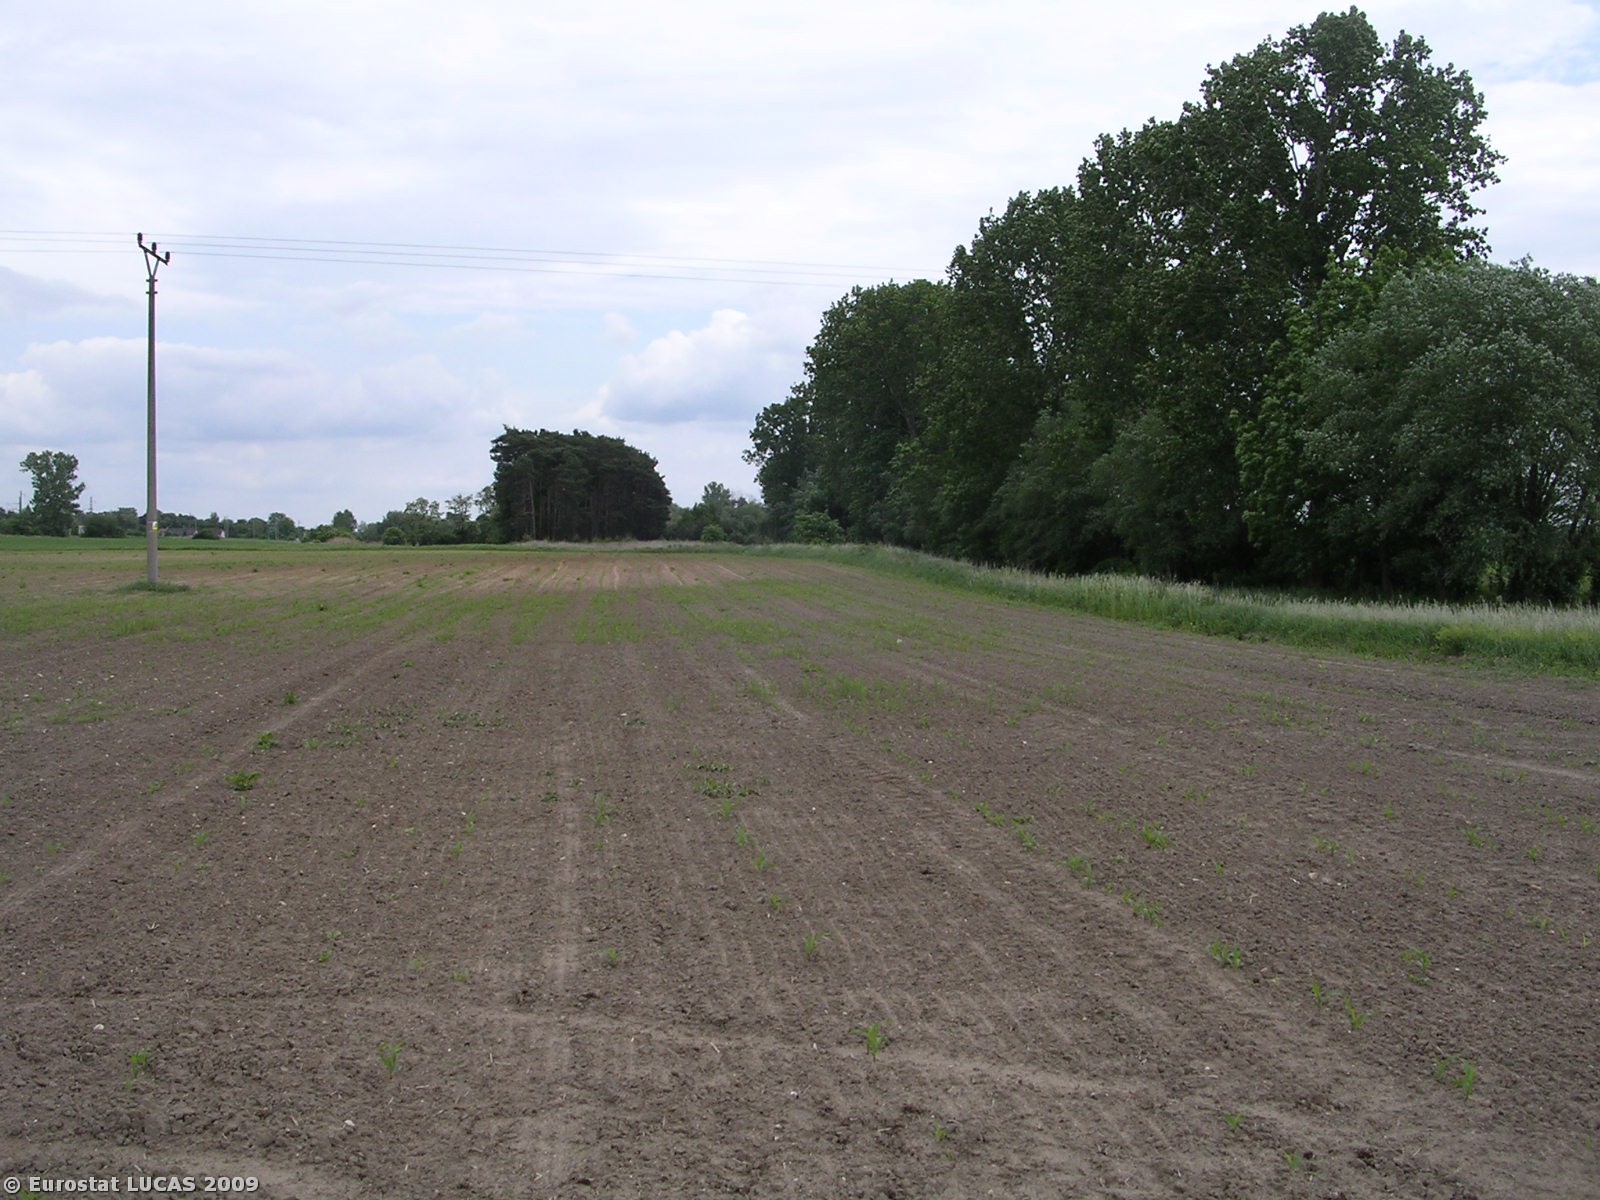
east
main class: Cropland
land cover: Maize
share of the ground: < 10 %
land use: Agriculture (excluding fallow land and kitchen gardens)
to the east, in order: Maize; Electric lines; Maize; Grassland without tree/shrub cover
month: May
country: CZ
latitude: 50.1863
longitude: 14.9185
